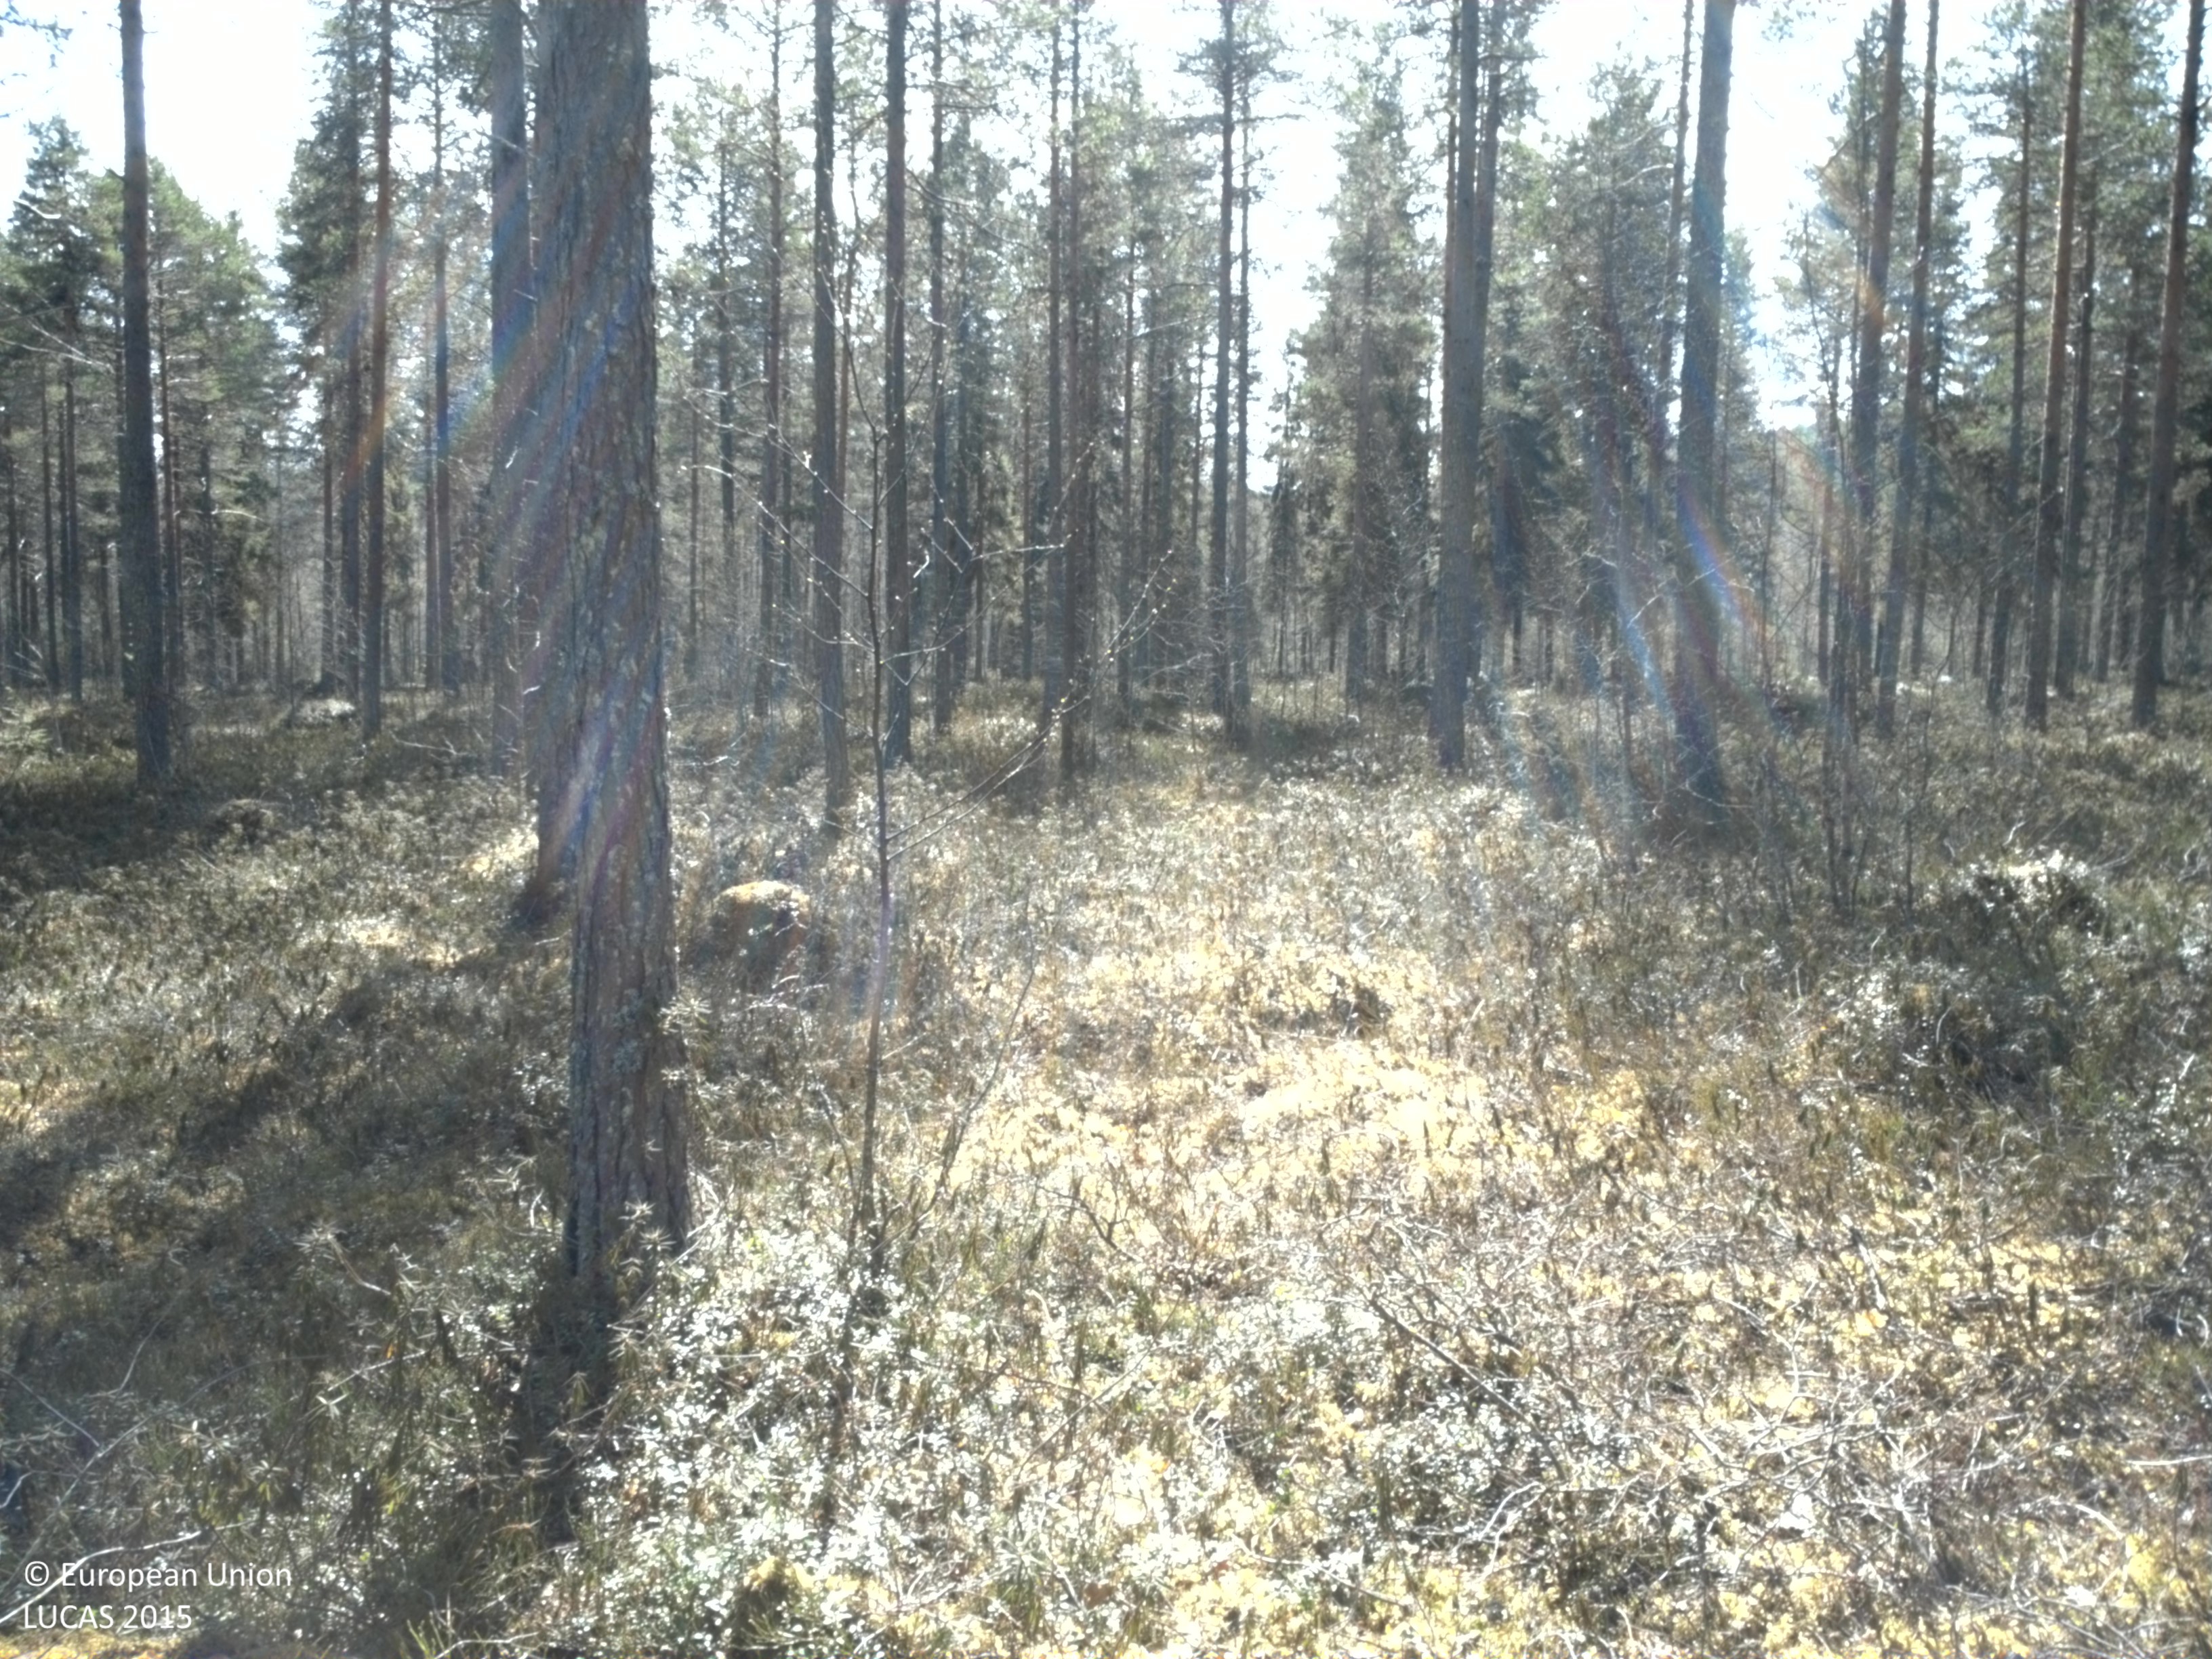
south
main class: Woodland
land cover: Pine dominated mixed woodland
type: boreal forest
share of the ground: 50 - 75 %
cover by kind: coniferous forest trees 45 %, shrubs 40 %, broadleaved forest trees 15 %
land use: Forestry
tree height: > 5 m
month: May
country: SE
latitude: 66.3005
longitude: 23.5207
